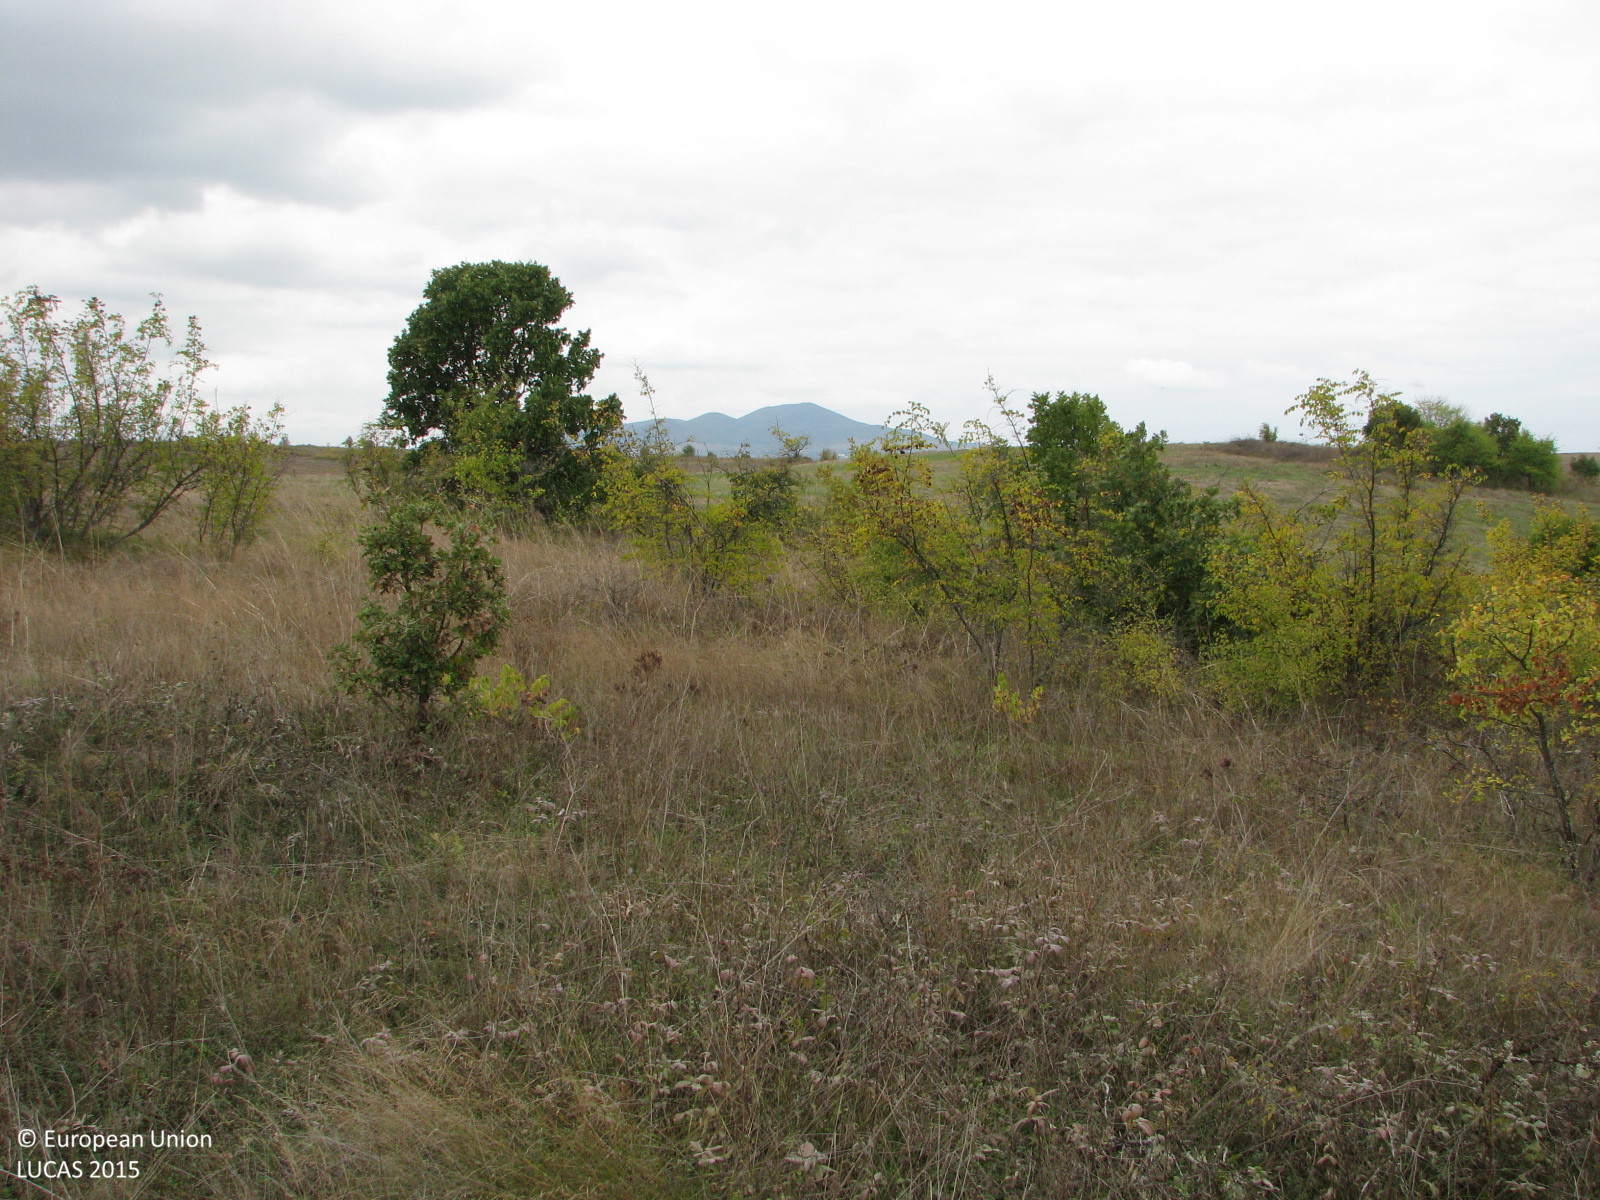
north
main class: Shrubland
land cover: Shrubland with sparse tree cover
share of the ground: 50 - 75 %
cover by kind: shrubs 60 %, herbaceous plants 35 %, broadleaved forest trees 5 %
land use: Semi-natural and natural areas not in use
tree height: < 5 m
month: October
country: BG
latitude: 42.1371
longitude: 26.3819
